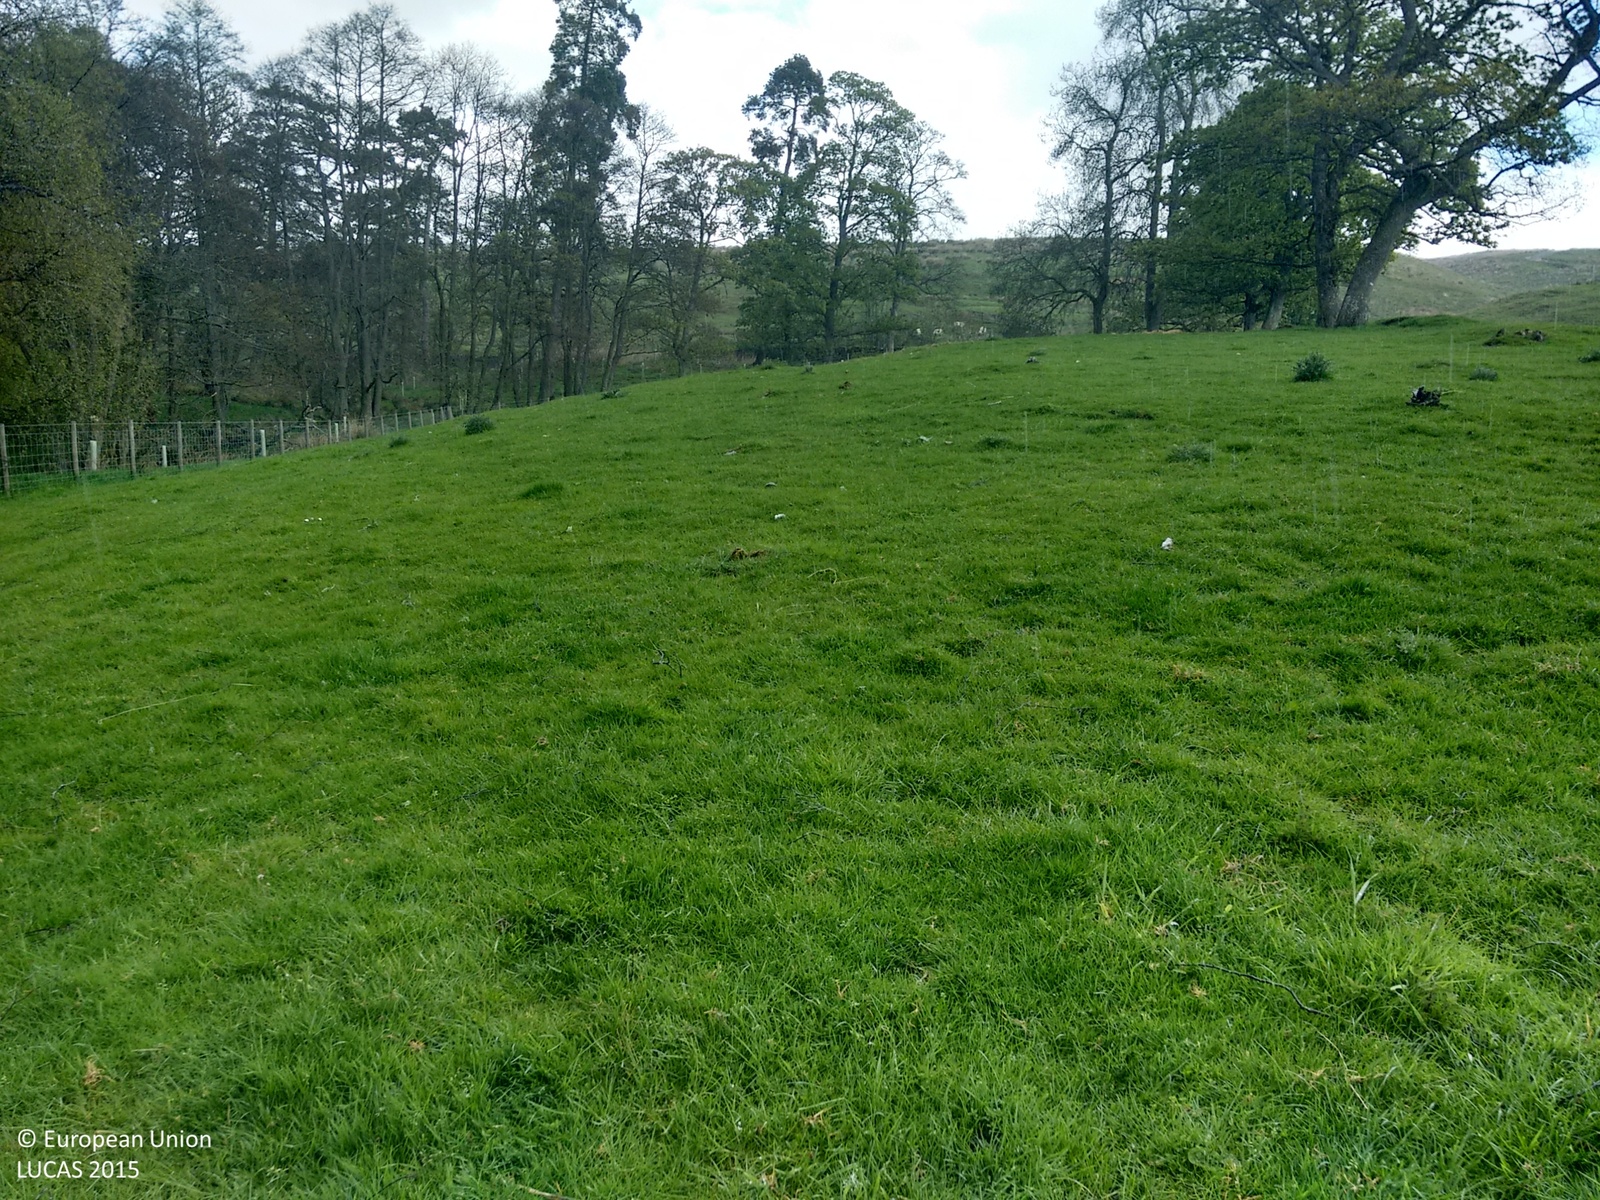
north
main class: Grassland
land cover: Grassland without tree/shrub cover
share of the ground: > 75 %
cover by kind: herbaceous plants 100 %
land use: Agriculture (excluding fallow land and kitchen gardens)
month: May
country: GB
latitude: 55.2699
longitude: -2.2554
